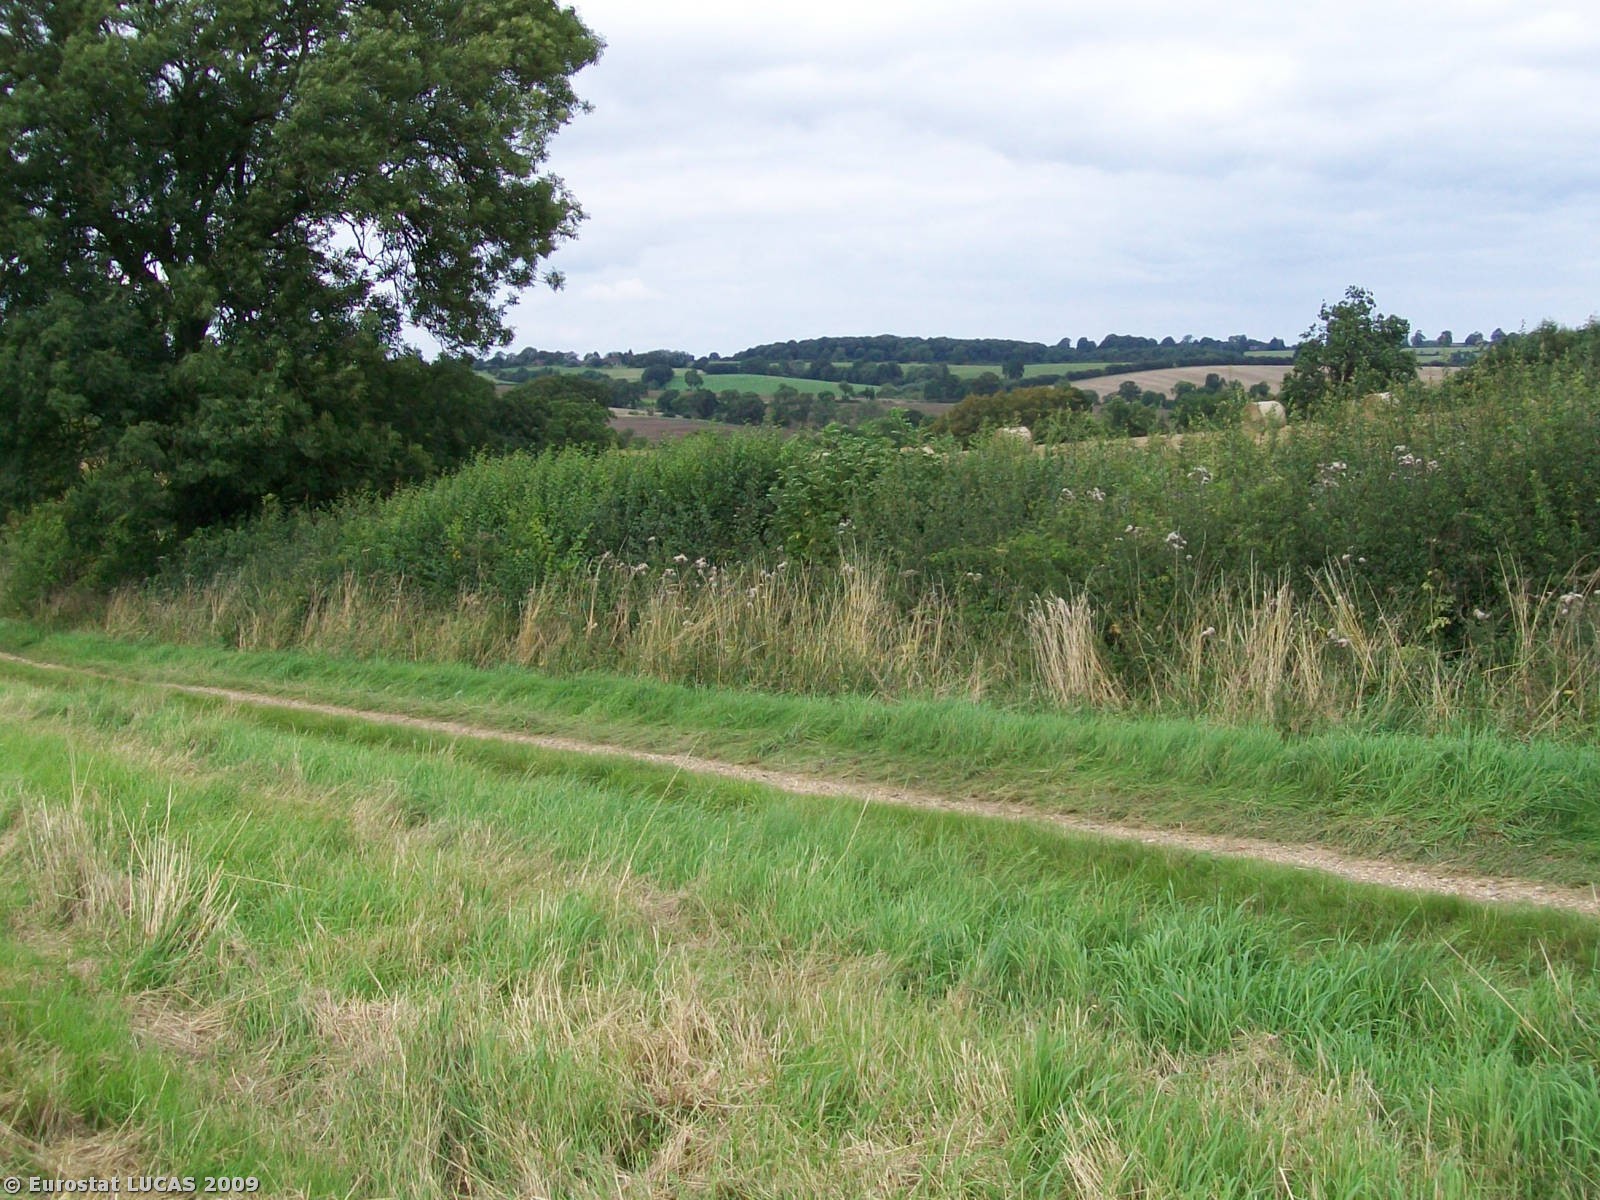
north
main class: Cropland
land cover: Common wheat
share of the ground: > 75 %
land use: Agriculture (excluding fallow land and kitchen gardens)
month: August
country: GB
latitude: 52.3331
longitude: -1.0365
